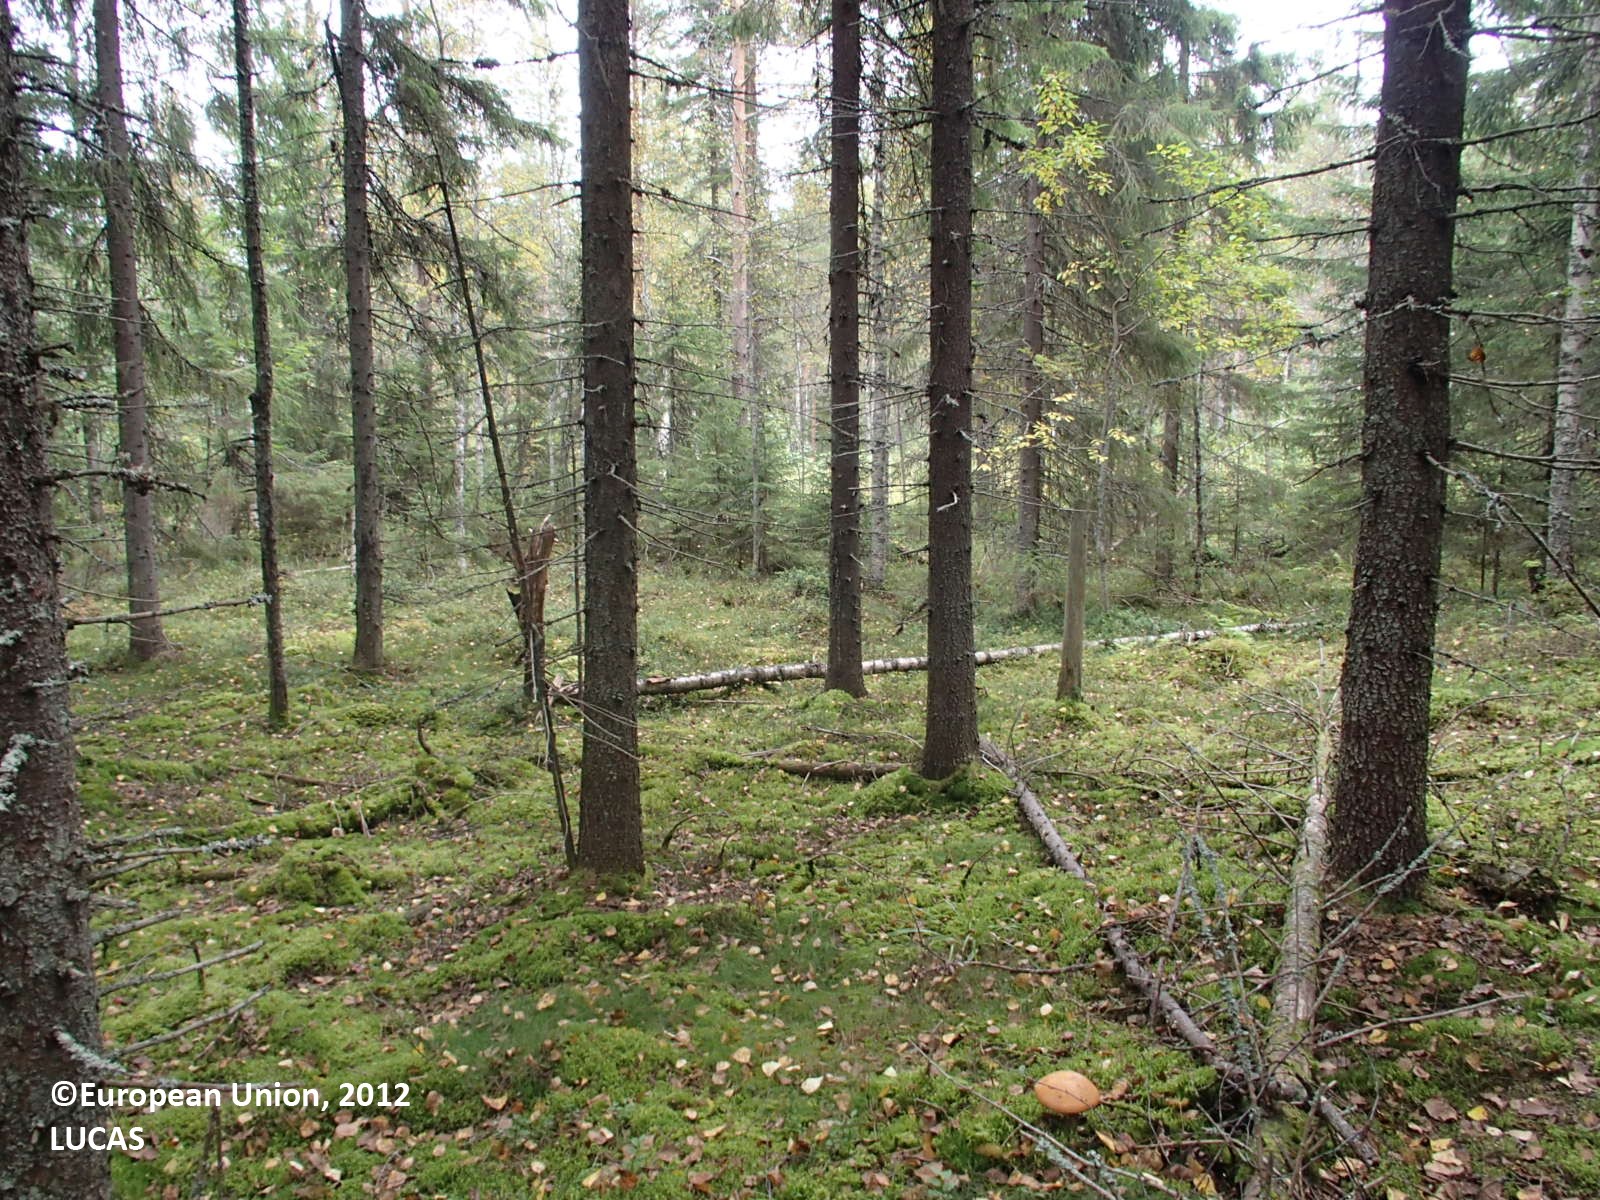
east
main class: Woodland
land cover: Spruce dominated mixed woodland
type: boreal forest
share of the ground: > 75 %
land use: Forestry
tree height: > 5 m
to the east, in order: Spruce dominated mixed woodland; Ditches and canals; Abandoned hedges; Paved roads, cycling and walking lanes; Grass margins; Ditches and canals; Spontaneously vegetated surfaces; Pine dominated mixed woodland; Ditches and canals; Pine dominated mixed woodland; Ditches and canals; Pine dominated mixed woodland; Ditches and canals; Pine dominated mixed woodland
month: September
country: FI
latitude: 63.8292
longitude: 27.2764
